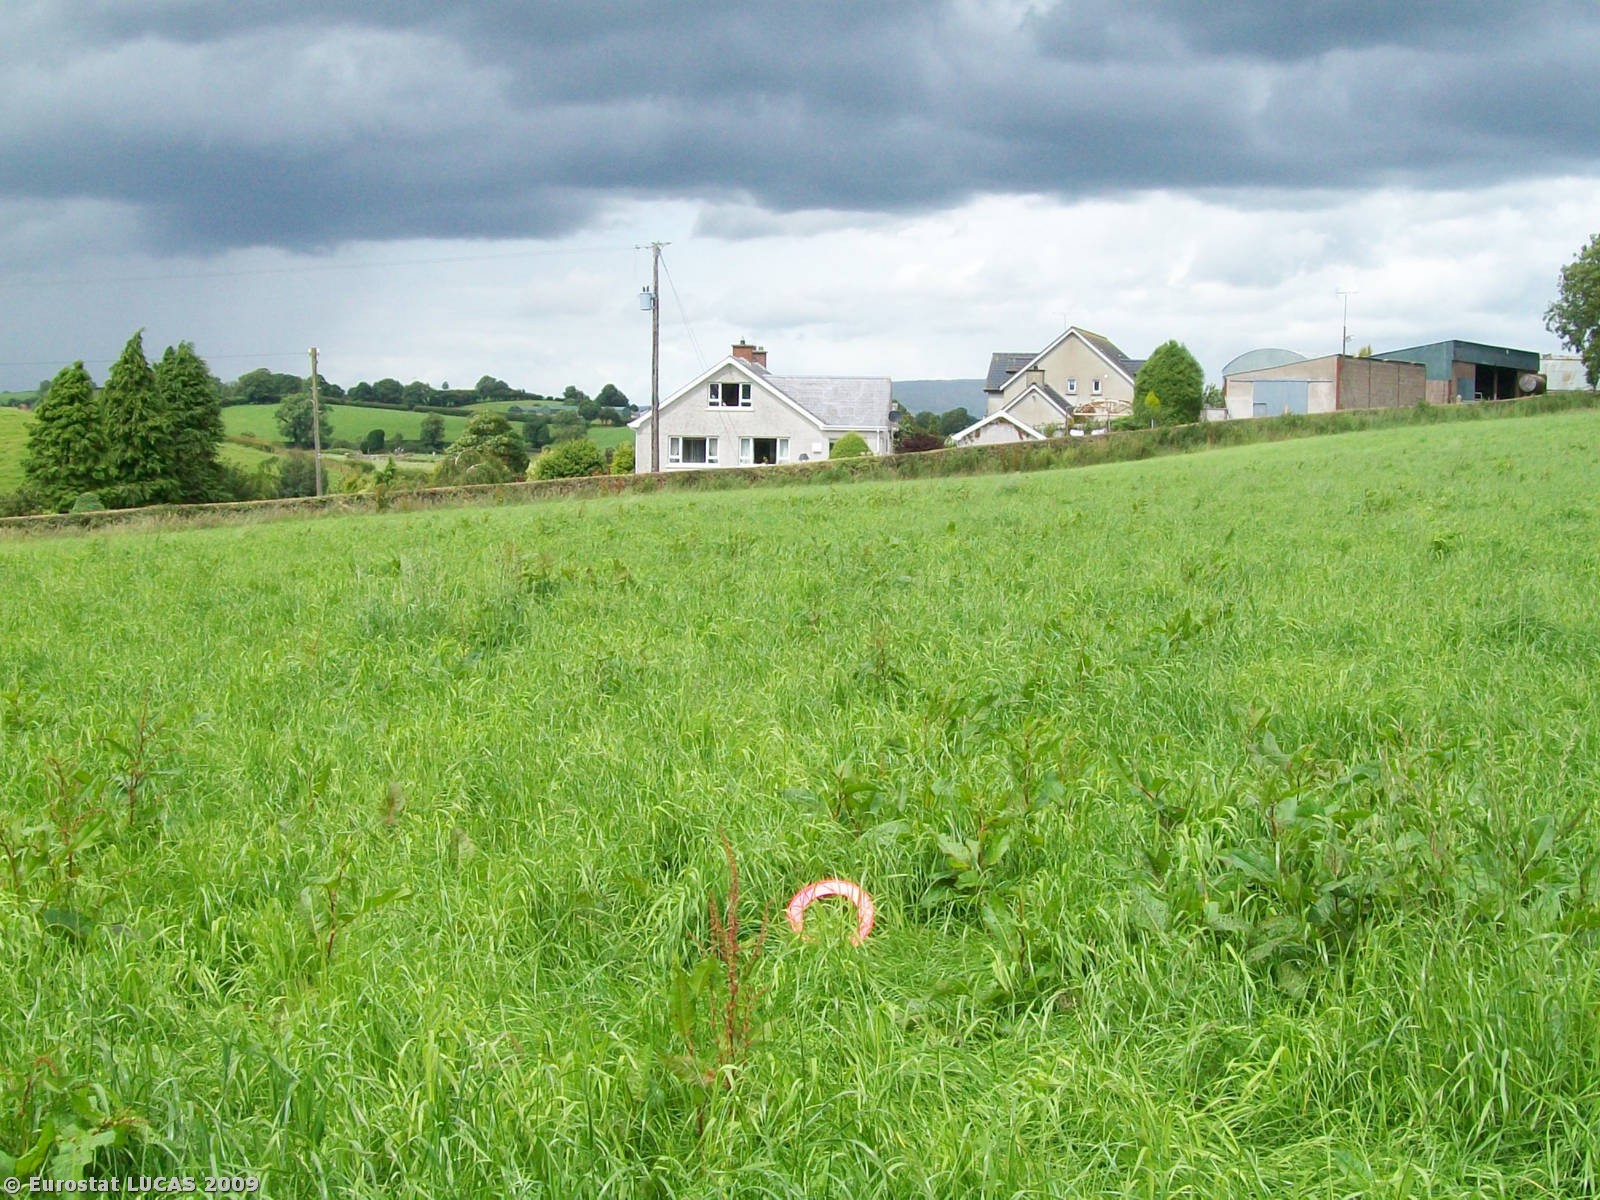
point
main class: Grassland
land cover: Grassland without tree/shrub cover
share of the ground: > 75 %
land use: Agriculture (excluding fallow land and kitchen gardens)
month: July
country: GB
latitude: 54.5842
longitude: -6.7019
